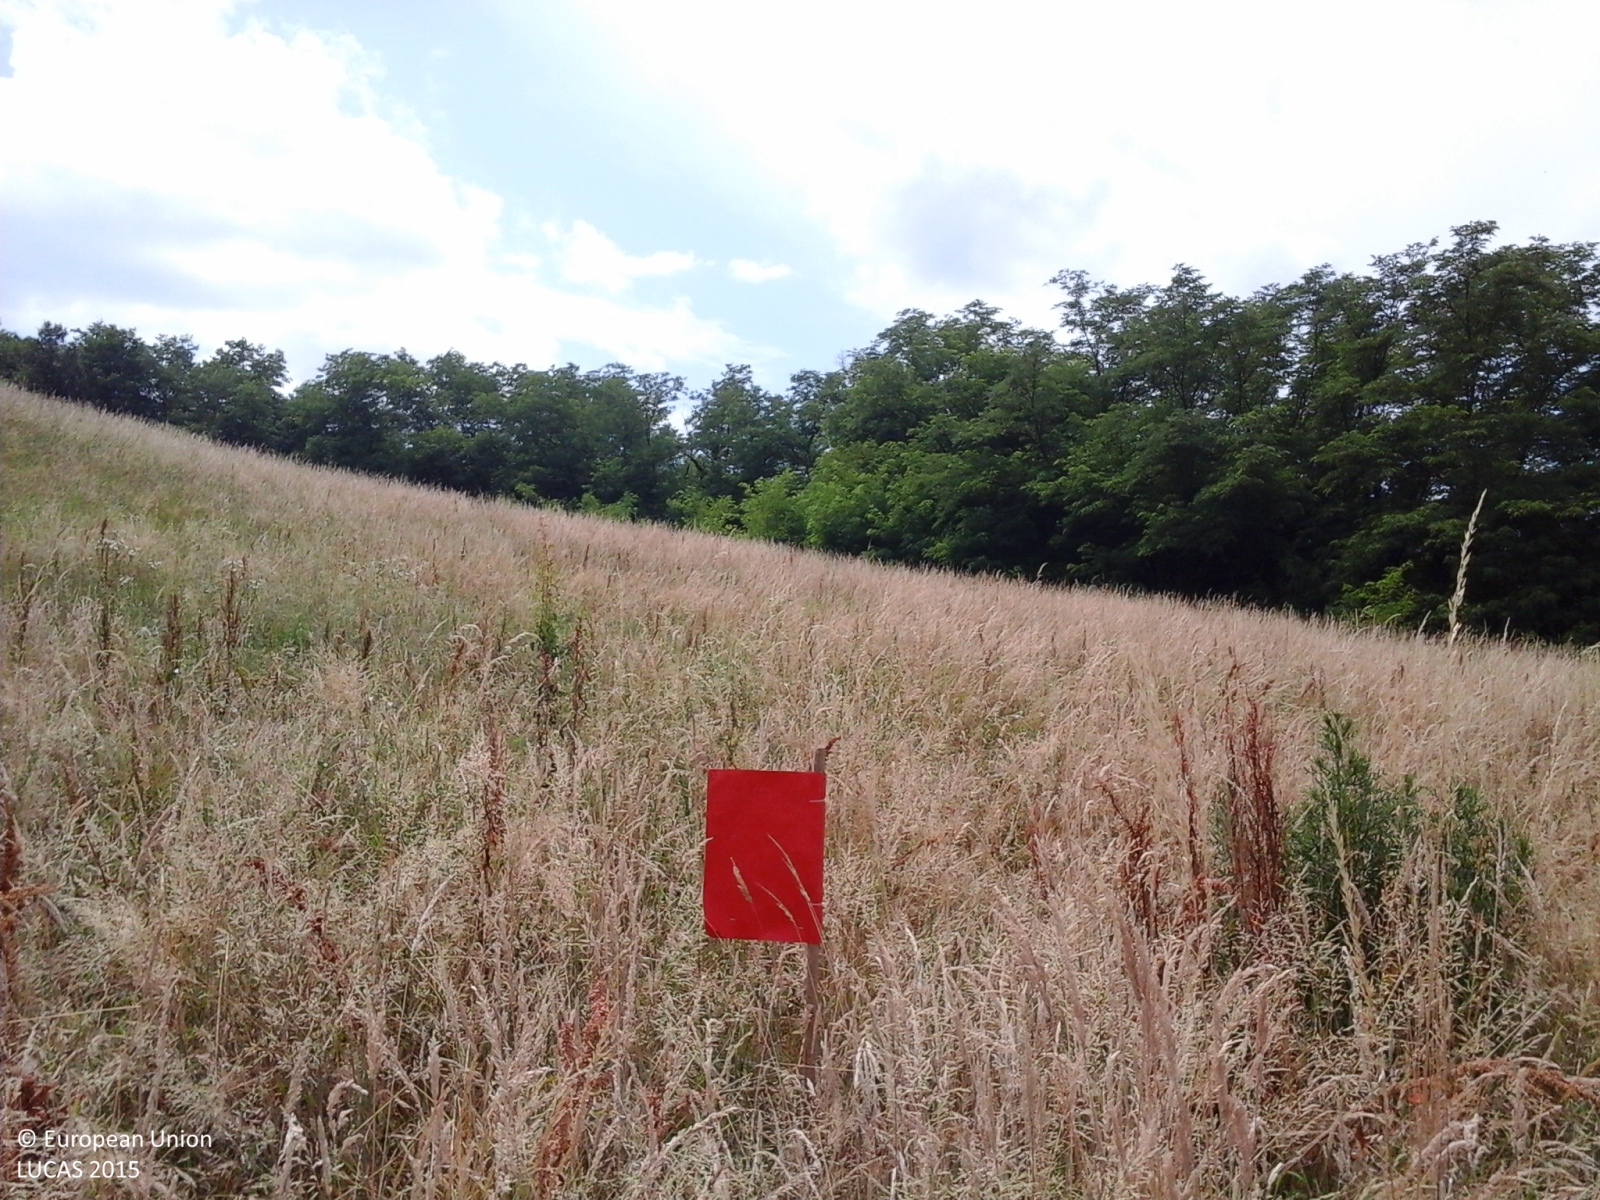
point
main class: Grassland
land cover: Grassland without tree/shrub cover
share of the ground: > 75 %
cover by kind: herbaceous plants 100 %
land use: Agriculture (excluding fallow land and kitchen gardens)
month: June
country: IT
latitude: 44.8730
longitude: 9.6589
